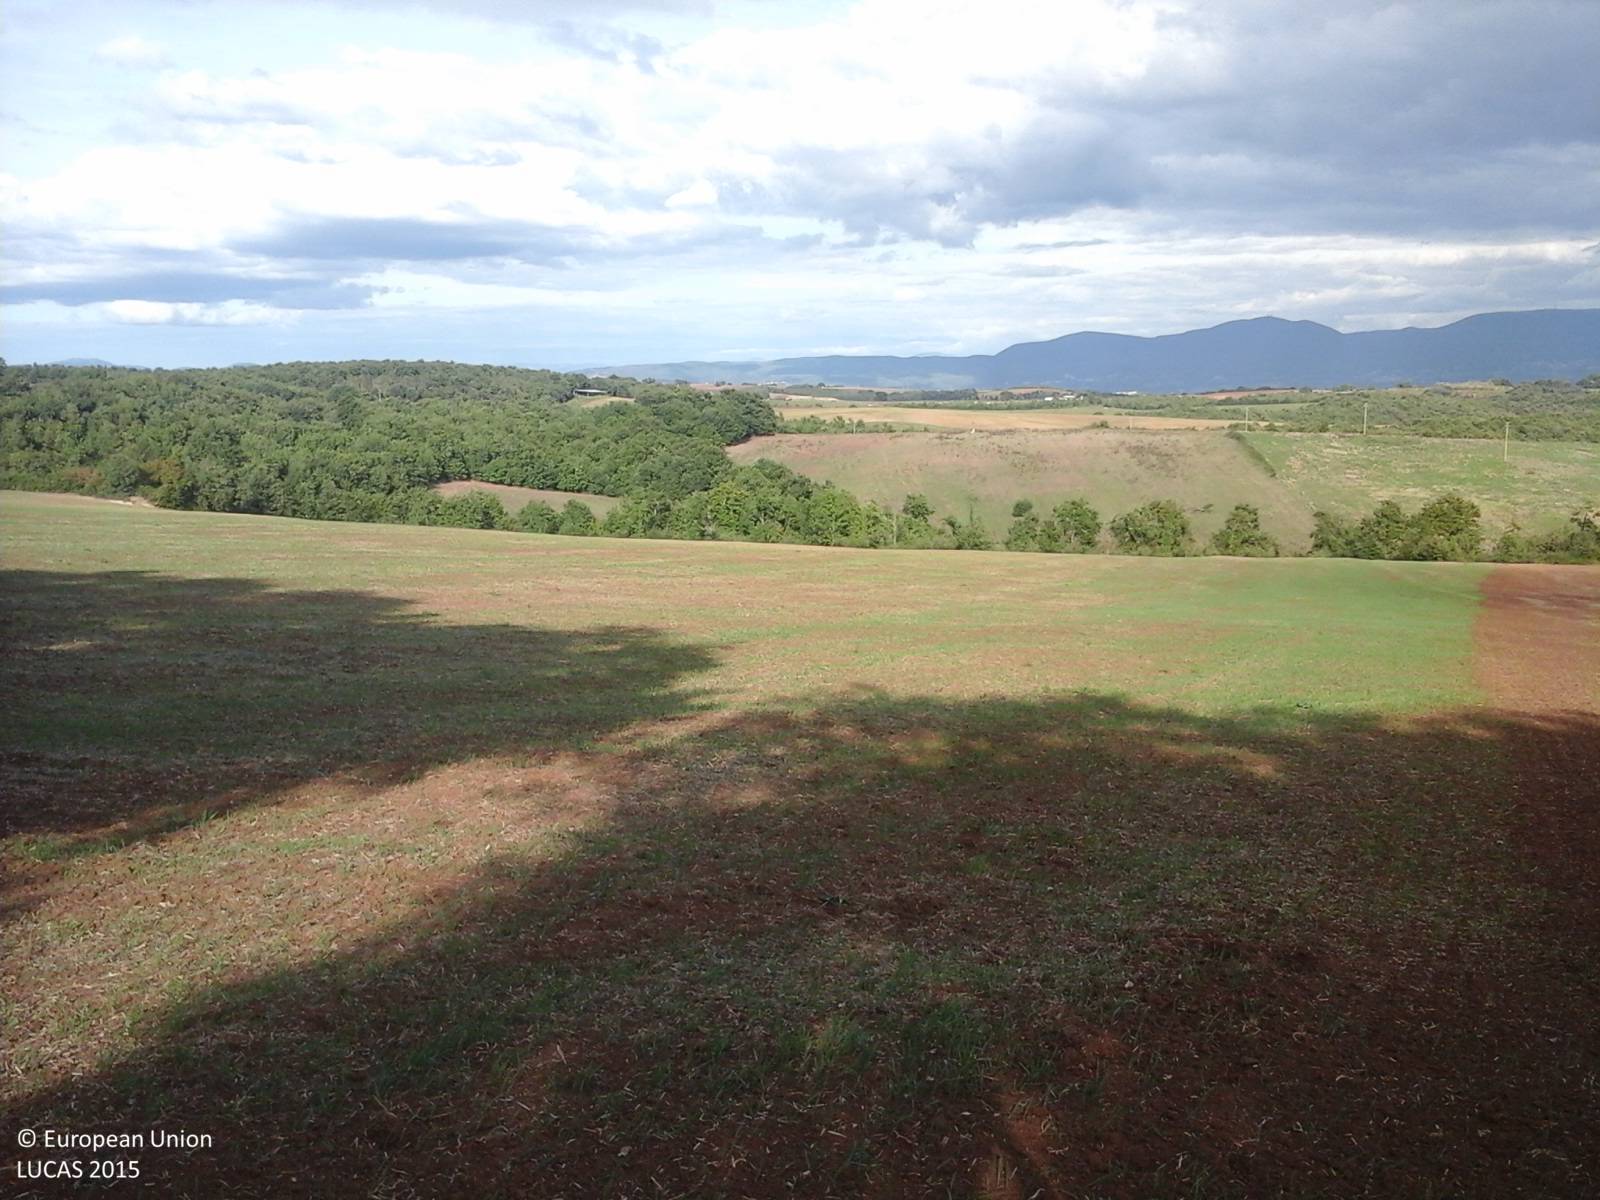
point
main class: Cropland
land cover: Oats
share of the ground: < 10 %
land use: Agriculture (excluding fallow land and kitchen gardens)
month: September
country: IT
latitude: 42.3910
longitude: 12.3850
